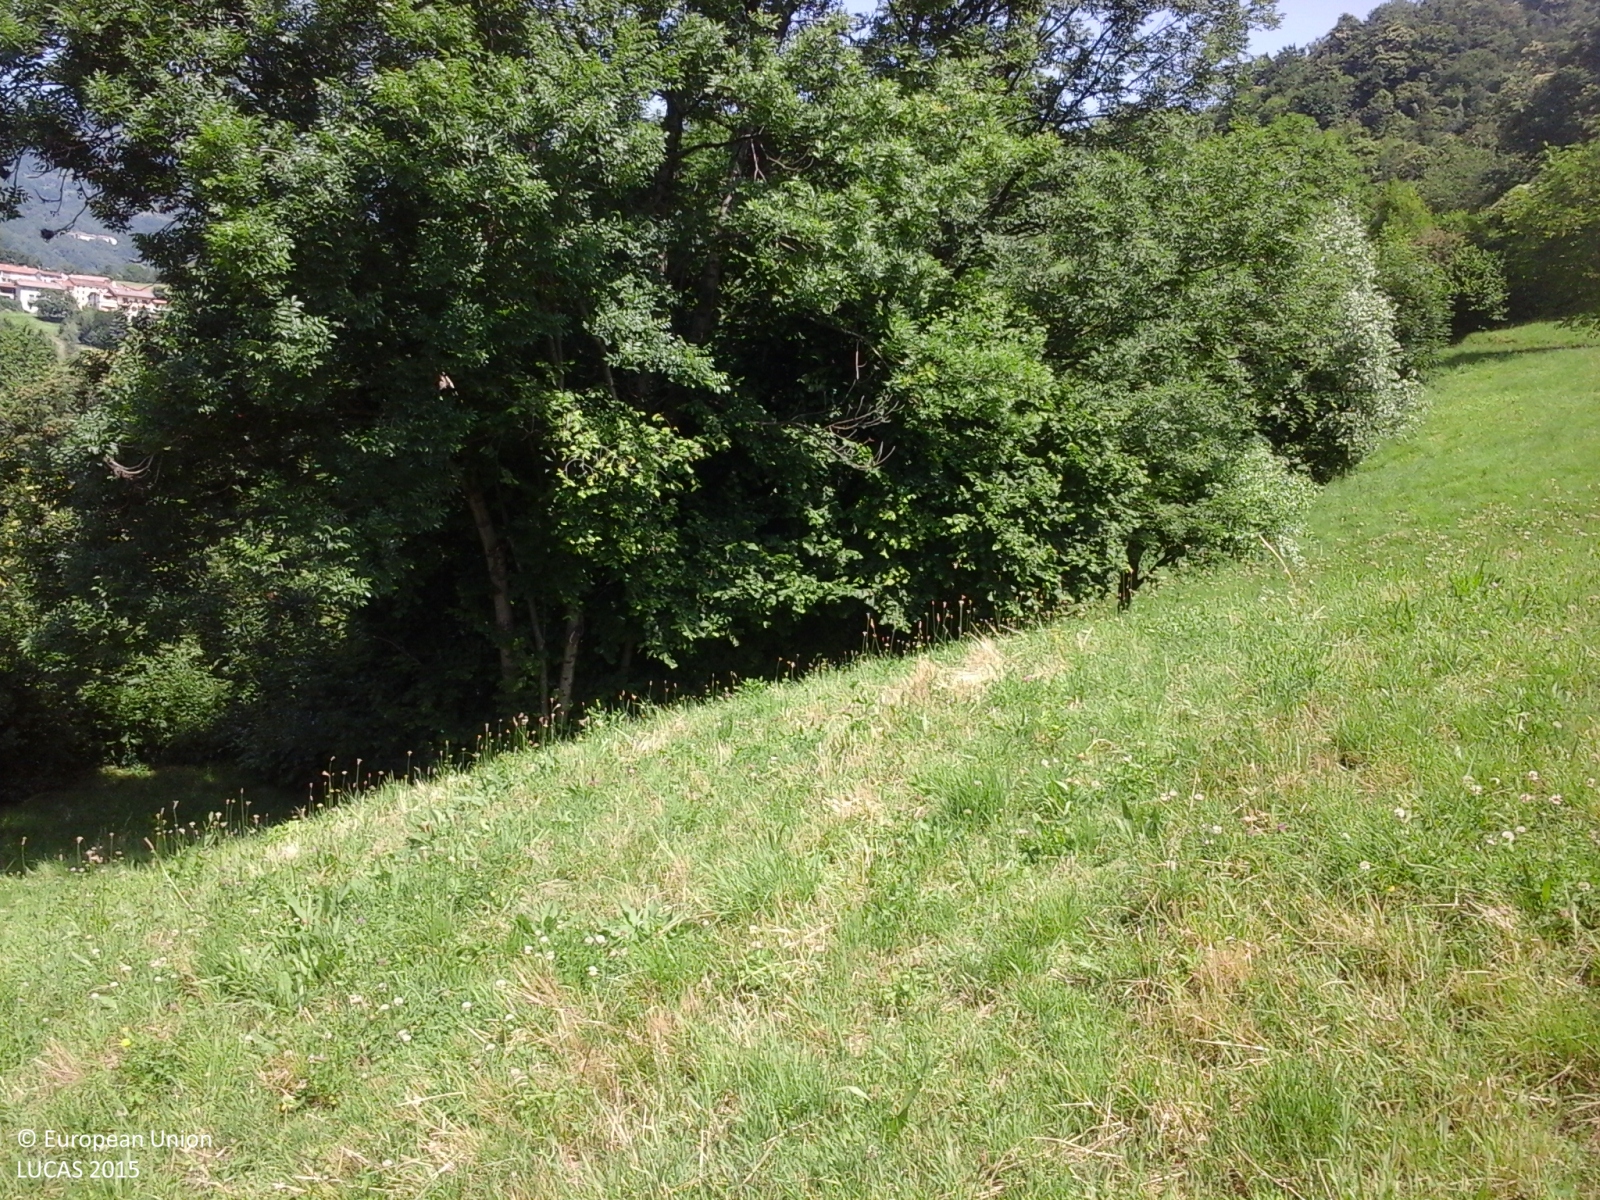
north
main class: Grassland
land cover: Grassland without tree/shrub cover
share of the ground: > 75 %
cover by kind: herbaceous plants 100 %
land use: Agriculture (excluding fallow land and kitchen gardens)
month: July
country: IT
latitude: 45.6233
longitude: 11.2421
